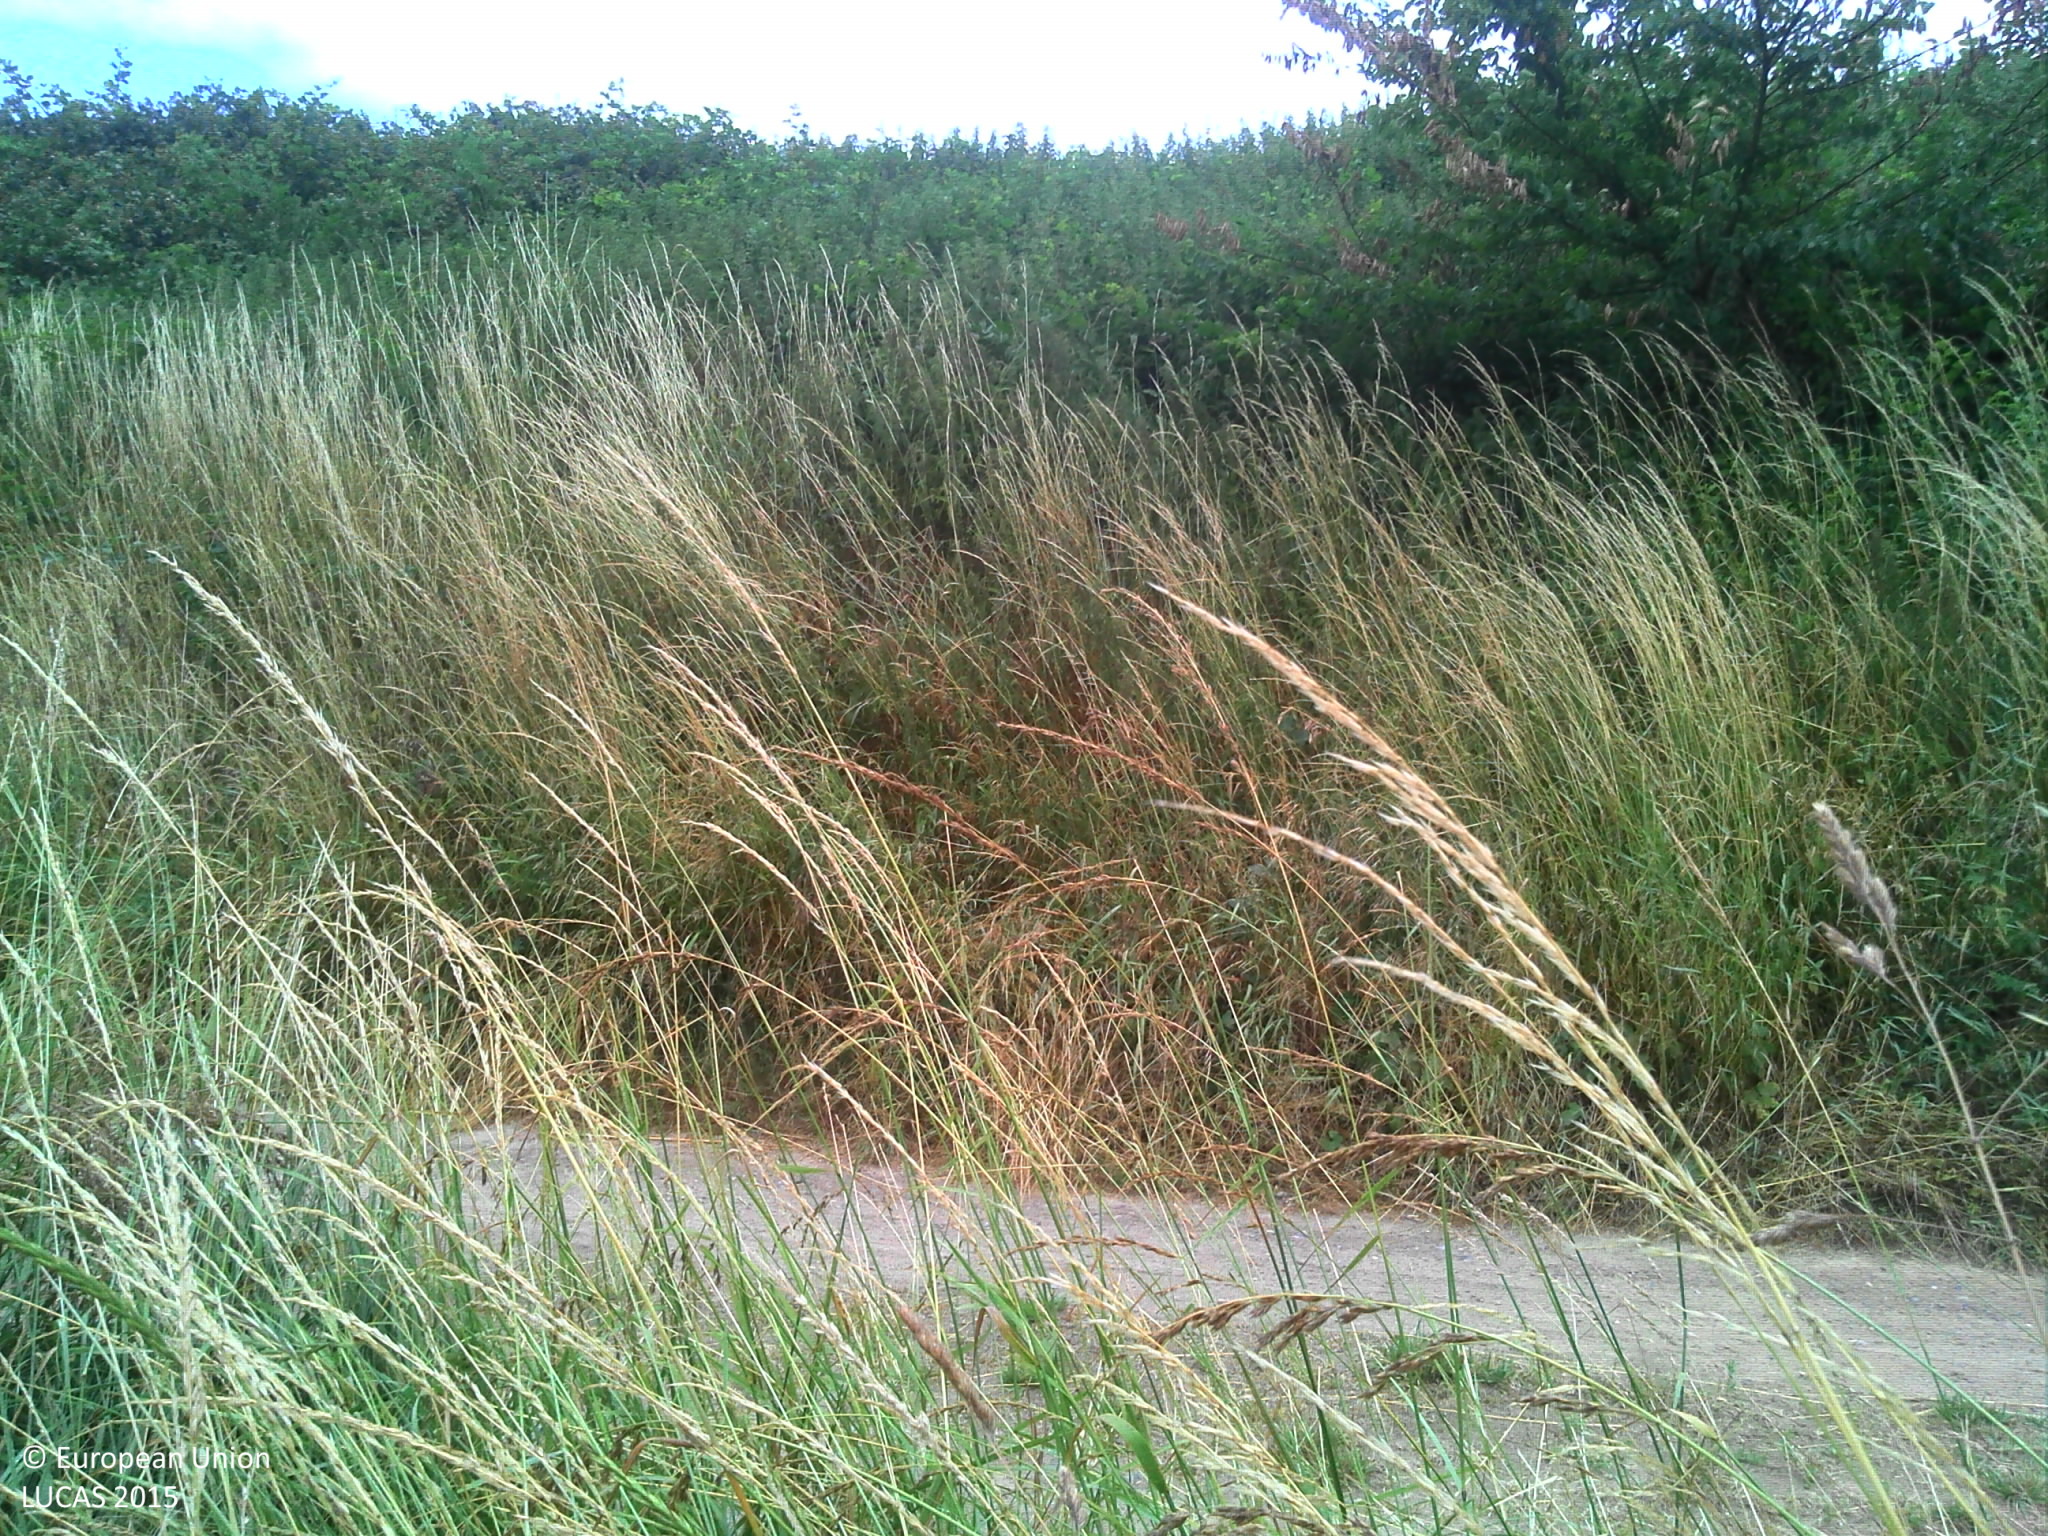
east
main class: Grassland
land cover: Grassland without tree/shrub cover
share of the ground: > 75 %
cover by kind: herbaceous plants 95 %, shrubs 5 %
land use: Agriculture (excluding fallow land and kitchen gardens)
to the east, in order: Grassland without tree/shrub cover; Fences; Grass margins; Tracks; Abandoned hedges; Durum wheat
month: July
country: BE
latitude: 50.8064
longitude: 4.8455
